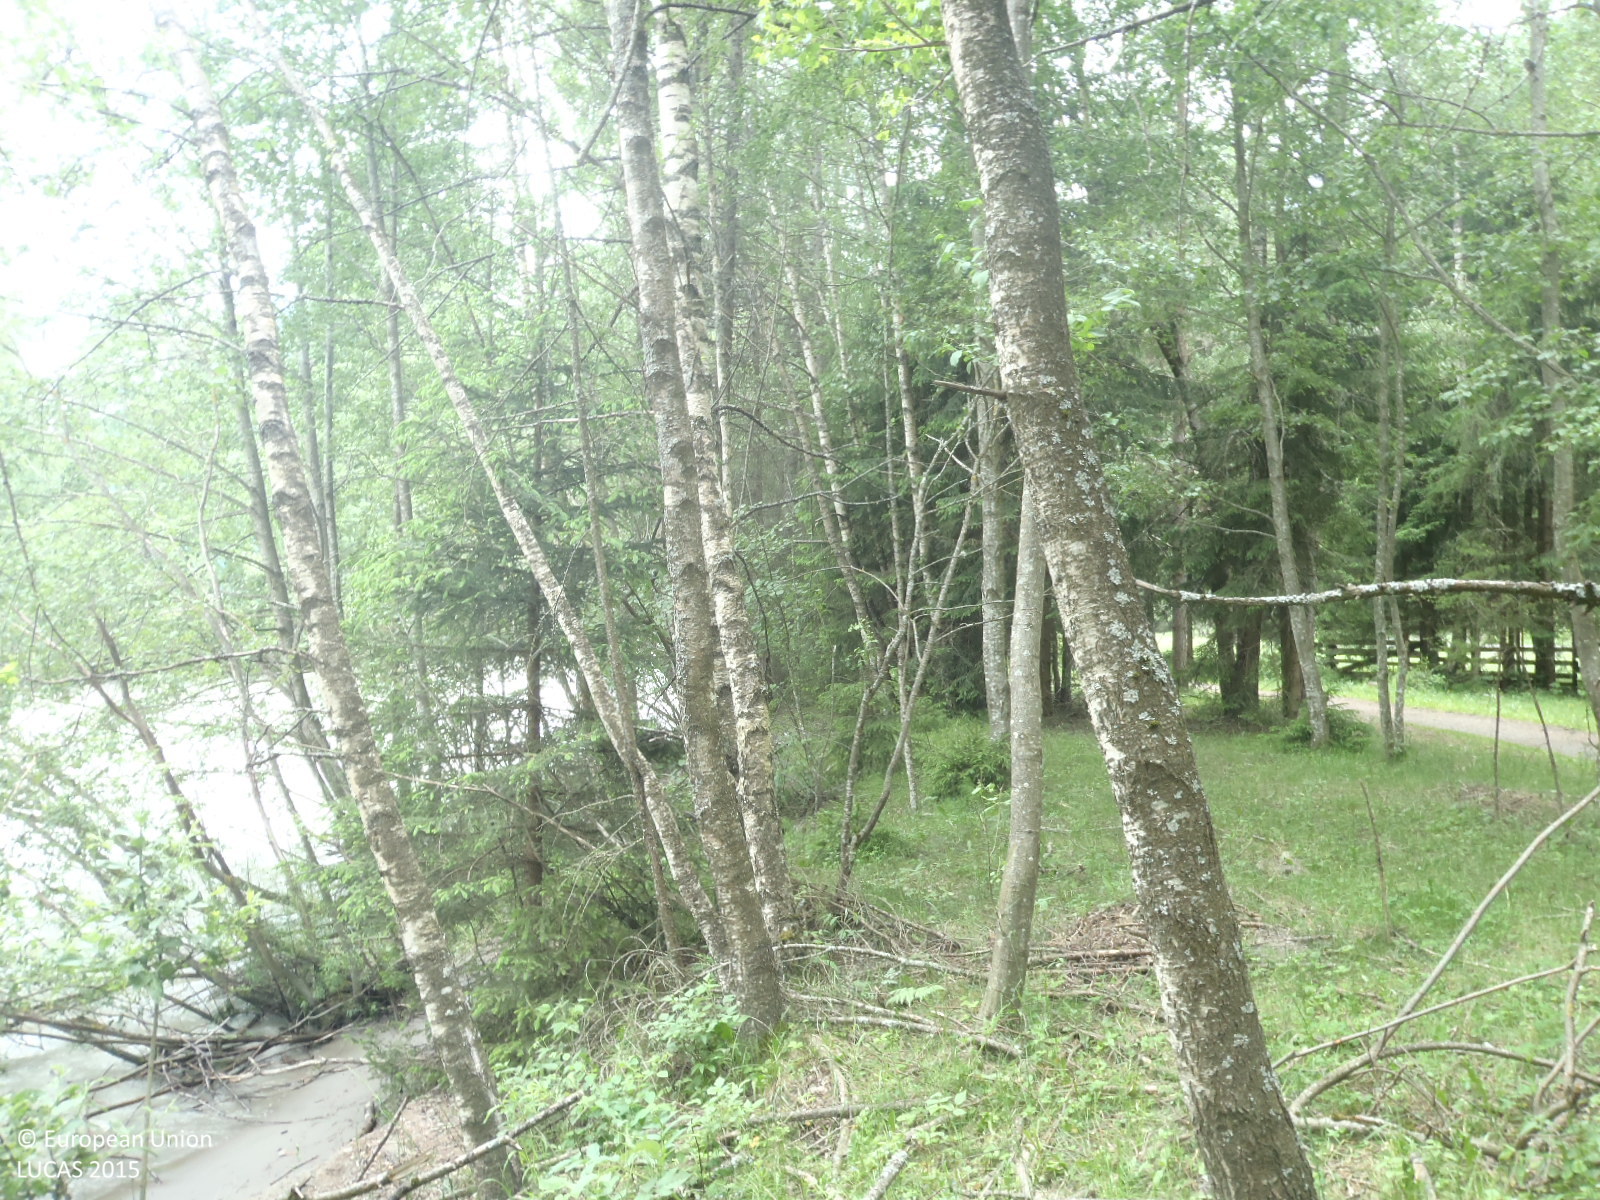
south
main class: Woodland
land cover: Pine dominated coniferous woodland
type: alpine coniferous forest
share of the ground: > 75 %
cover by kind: coniferous forest trees 85 %, shrubs 10 %, consolidated bare surface 5 %
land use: Semi-natural and natural areas not in use
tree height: > 5 m
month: June
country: AT
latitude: 47.0673
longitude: 10.9603
